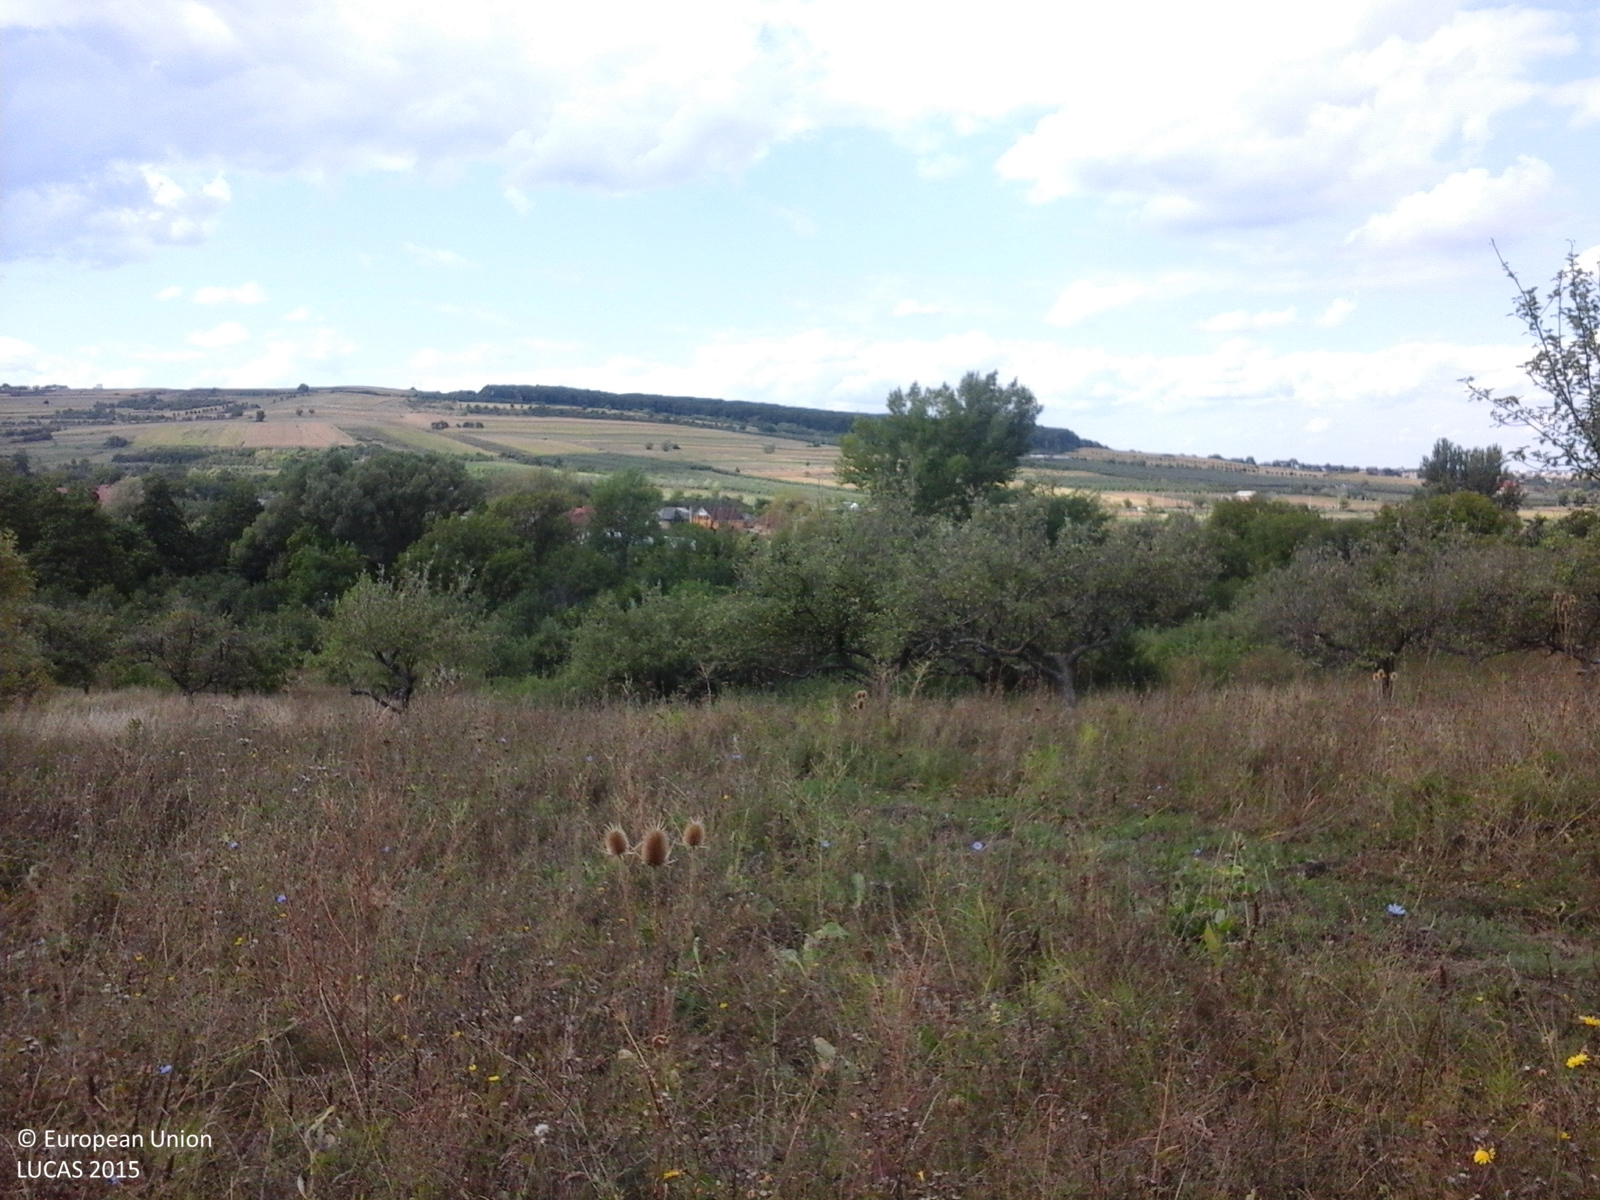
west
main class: Cropland
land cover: Apple fruit
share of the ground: > 75 %
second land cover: Spontaneously vegetated surfaces
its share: > 75 %
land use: Agriculture (excluding fallow land and kitchen gardens)
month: September
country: RO
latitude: 47.4809
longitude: 23.4899
